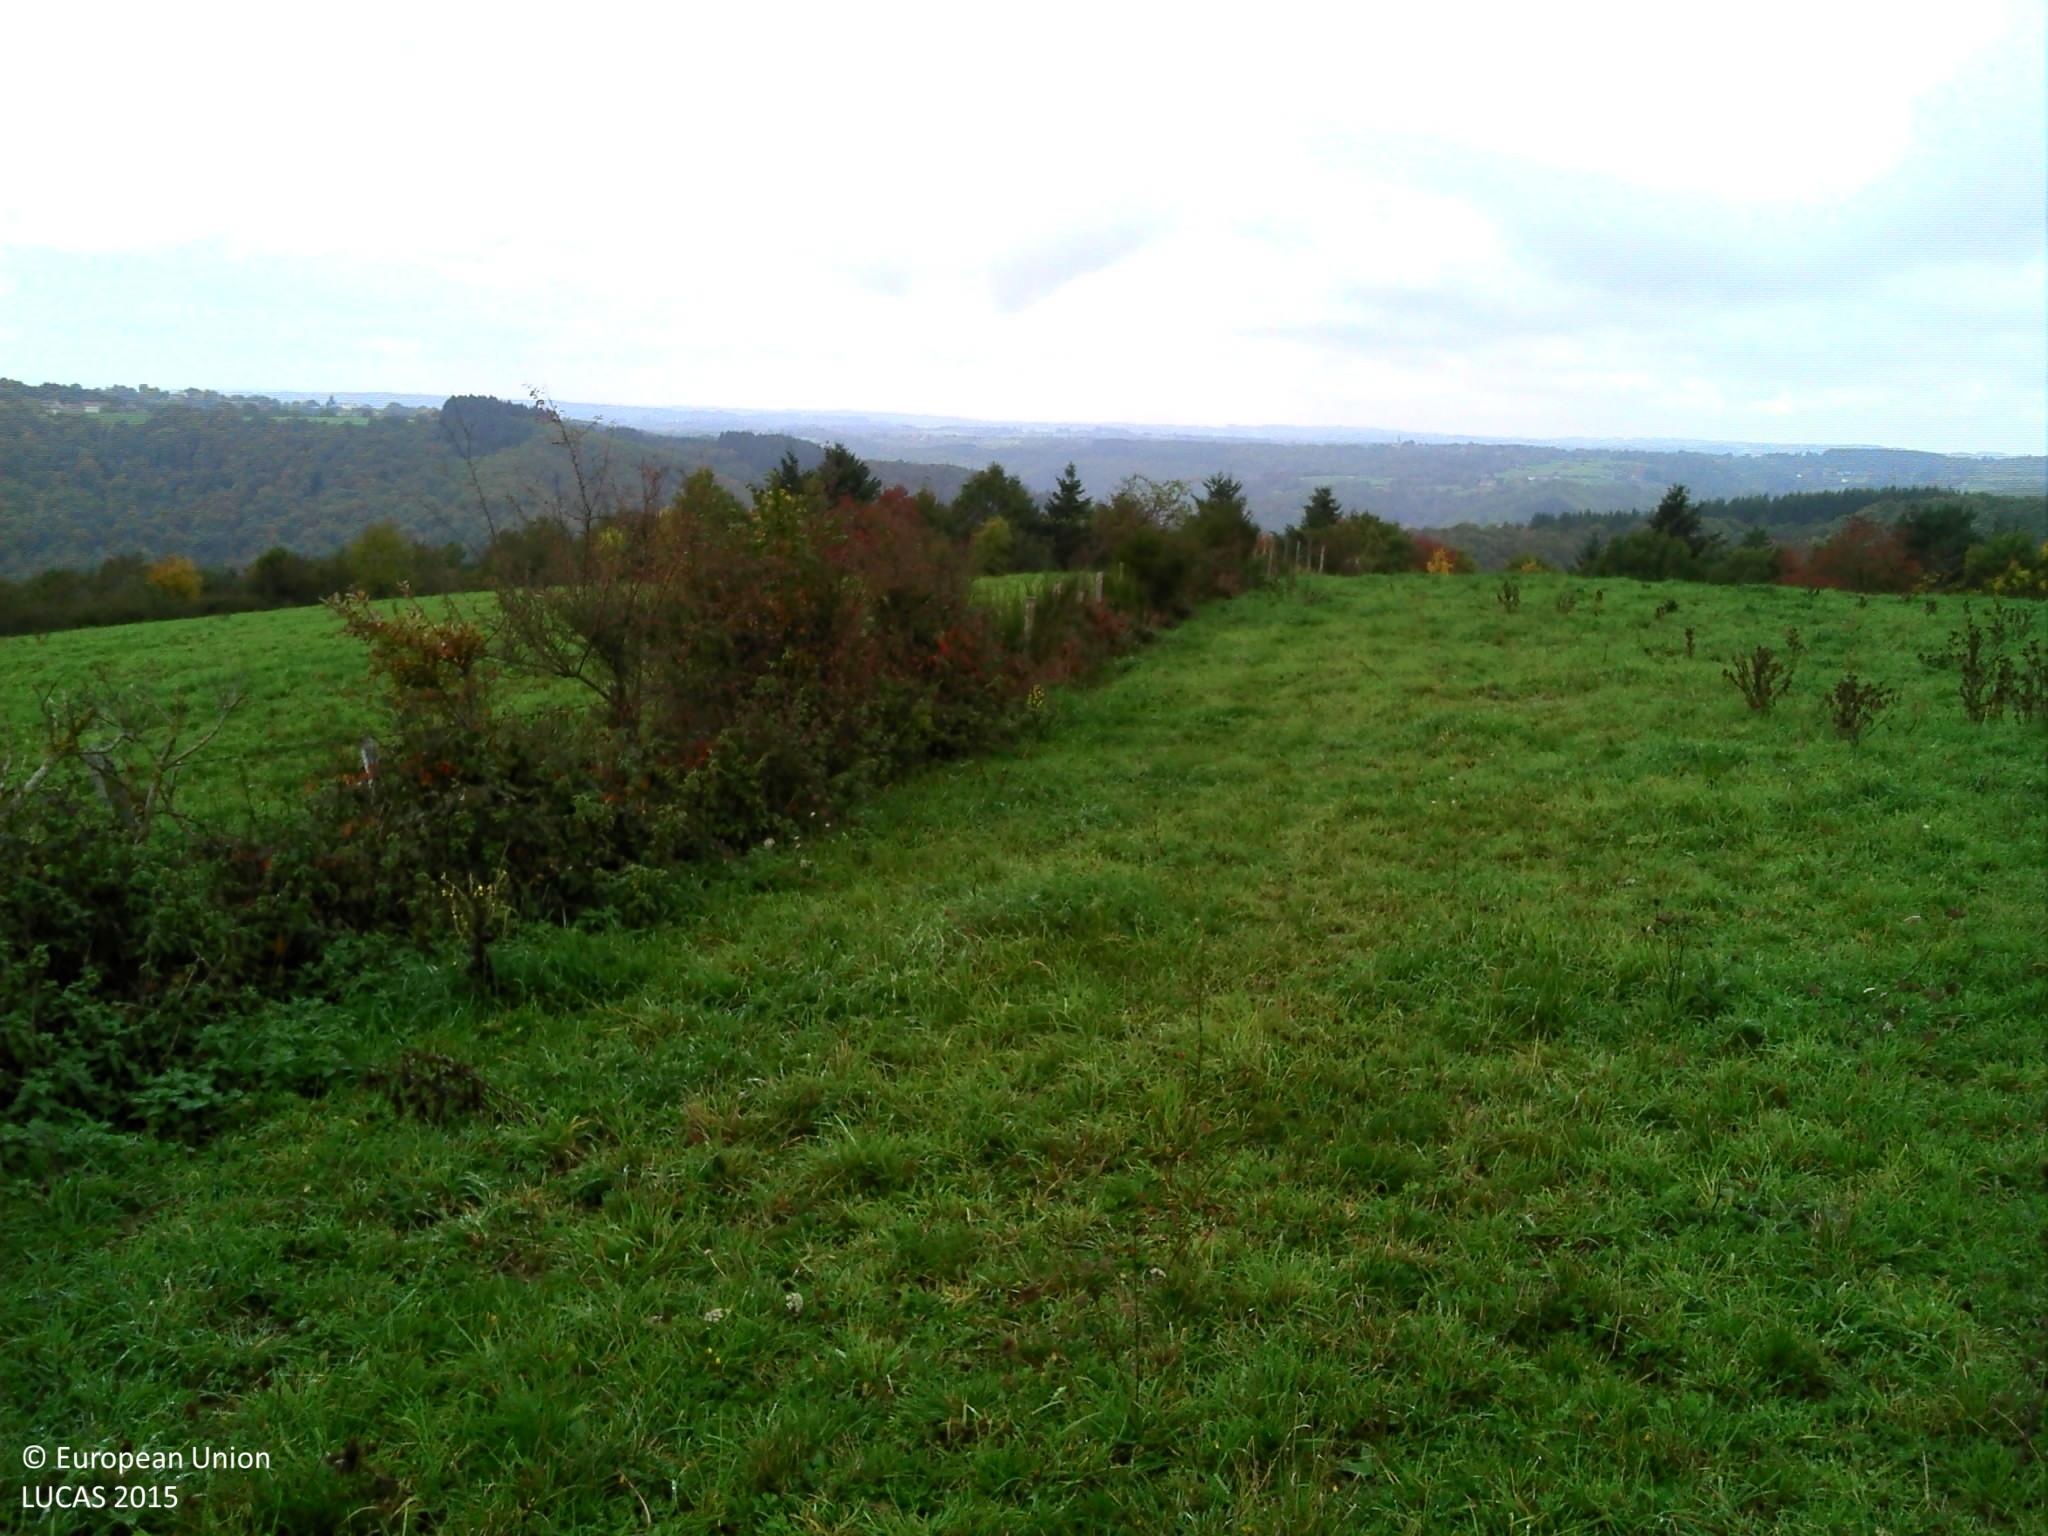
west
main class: Grassland
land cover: Grassland without tree/shrub cover
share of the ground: > 75 %
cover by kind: herbaceous plants 100 %
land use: Agriculture (excluding fallow land and kitchen gardens)
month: October
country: FR
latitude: 45.9859
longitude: 2.8595
